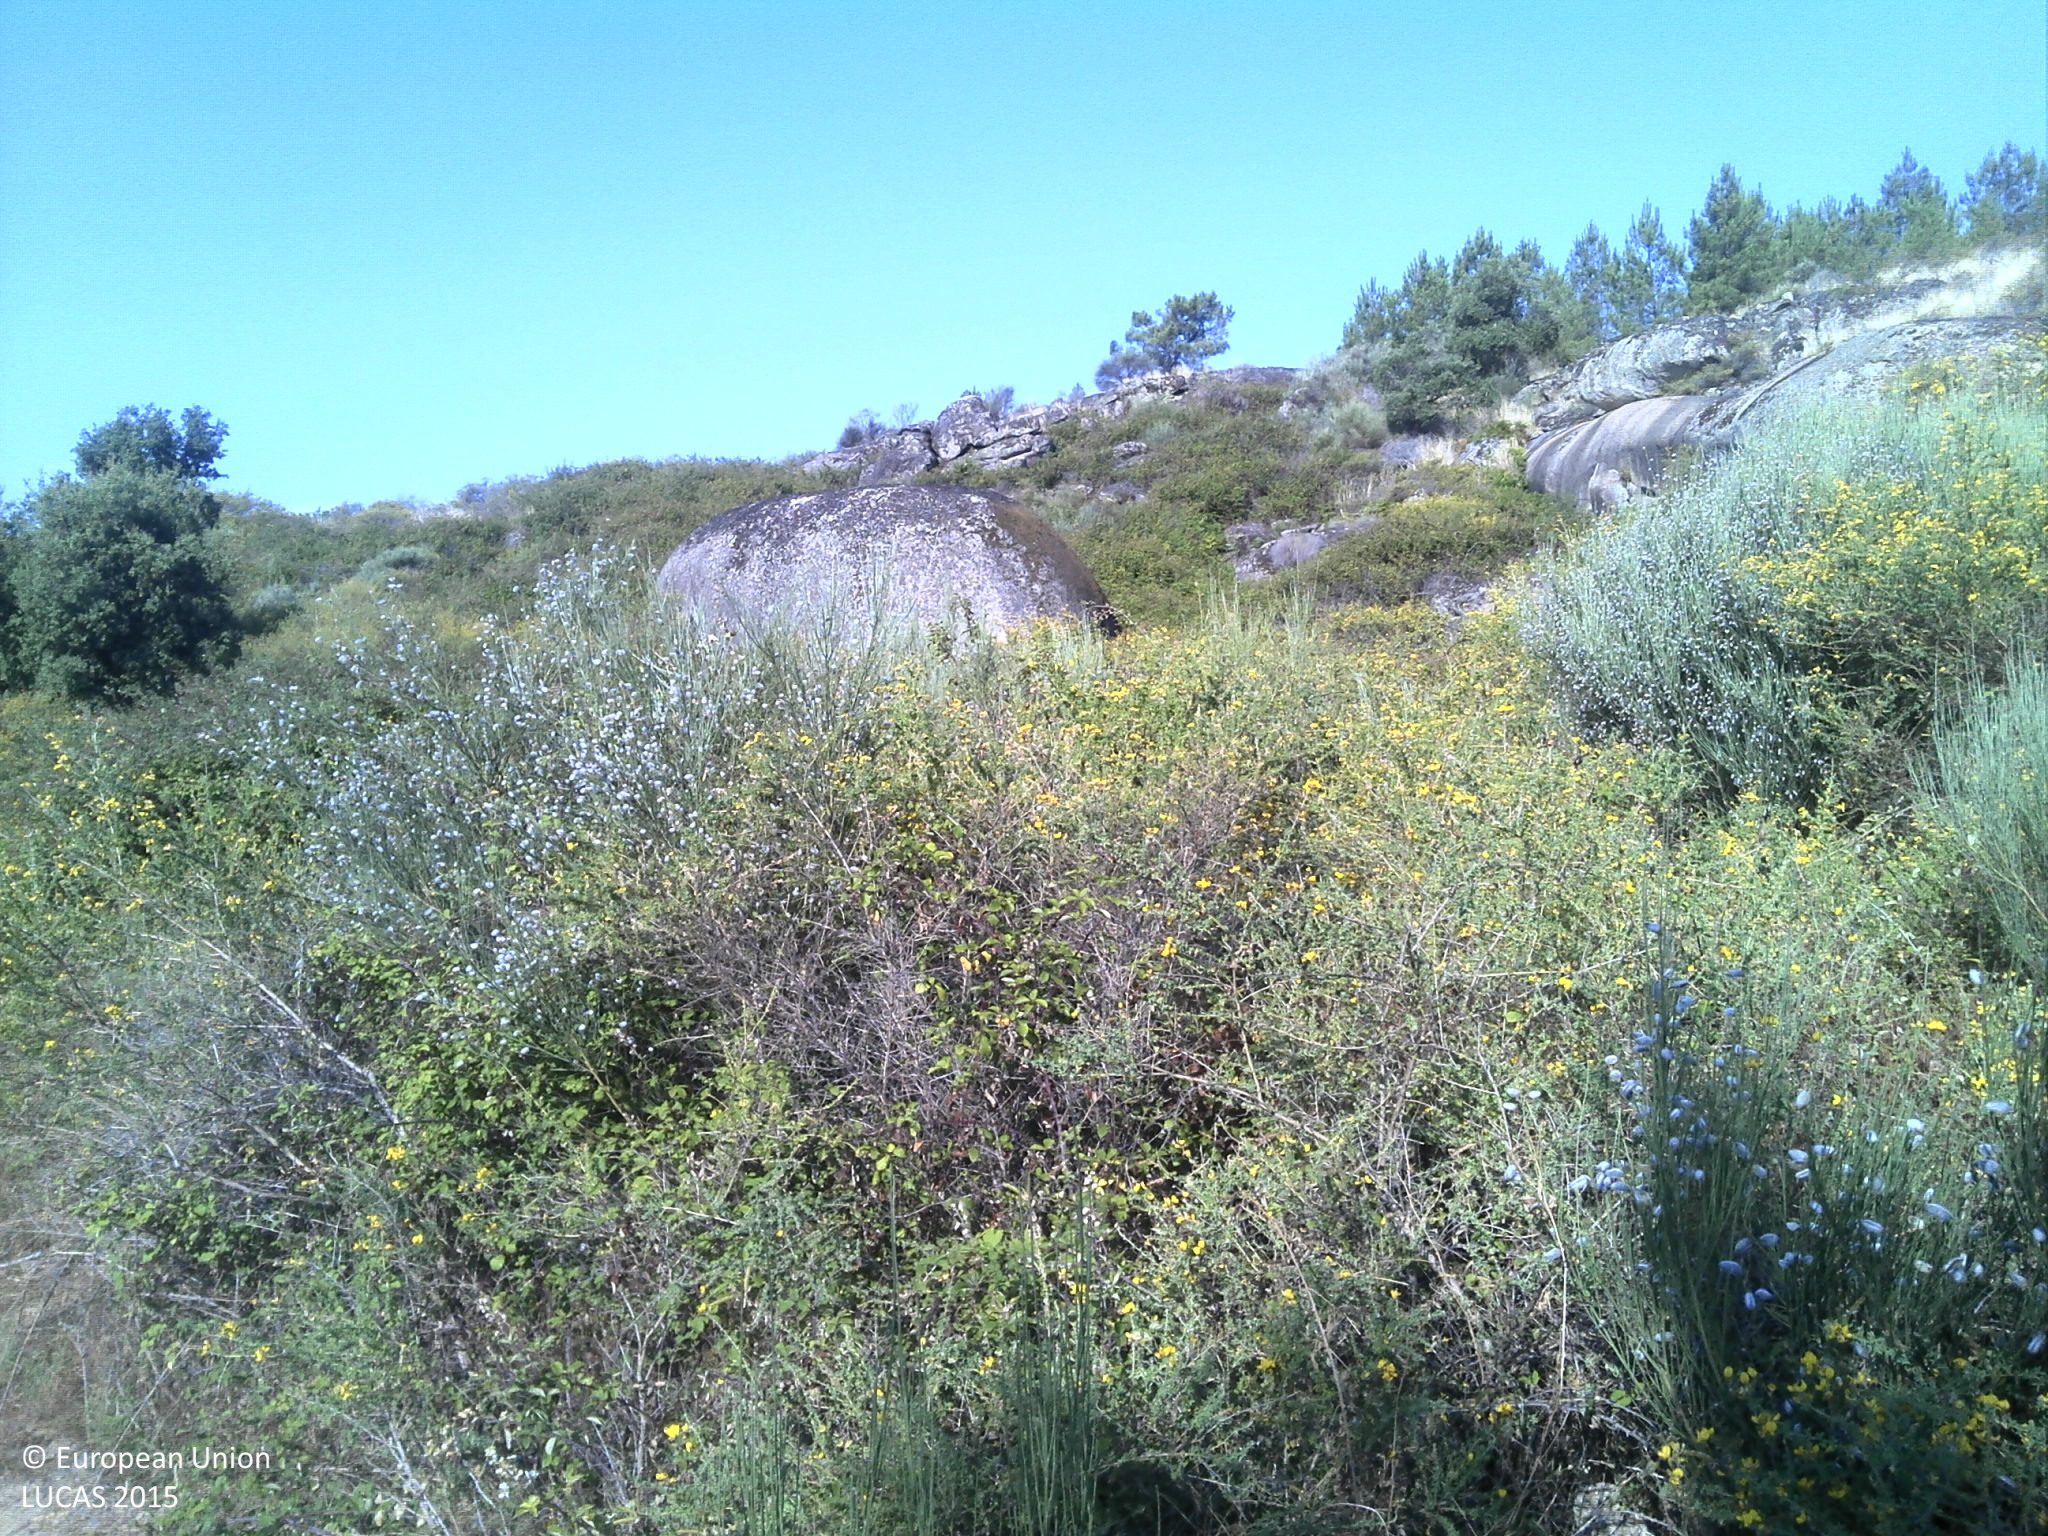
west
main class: Shrubland
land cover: Shrubland with sparse tree cover
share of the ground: 50 - 75 %
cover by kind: shrubs 70 %, herbaceous plants 15 %, coniferous forest trees 5 %, unconsolidated bare surface 5 %
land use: Semi-natural and natural areas not in use
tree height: < 5 m
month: June
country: PT
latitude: 40.0849
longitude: -7.1836
